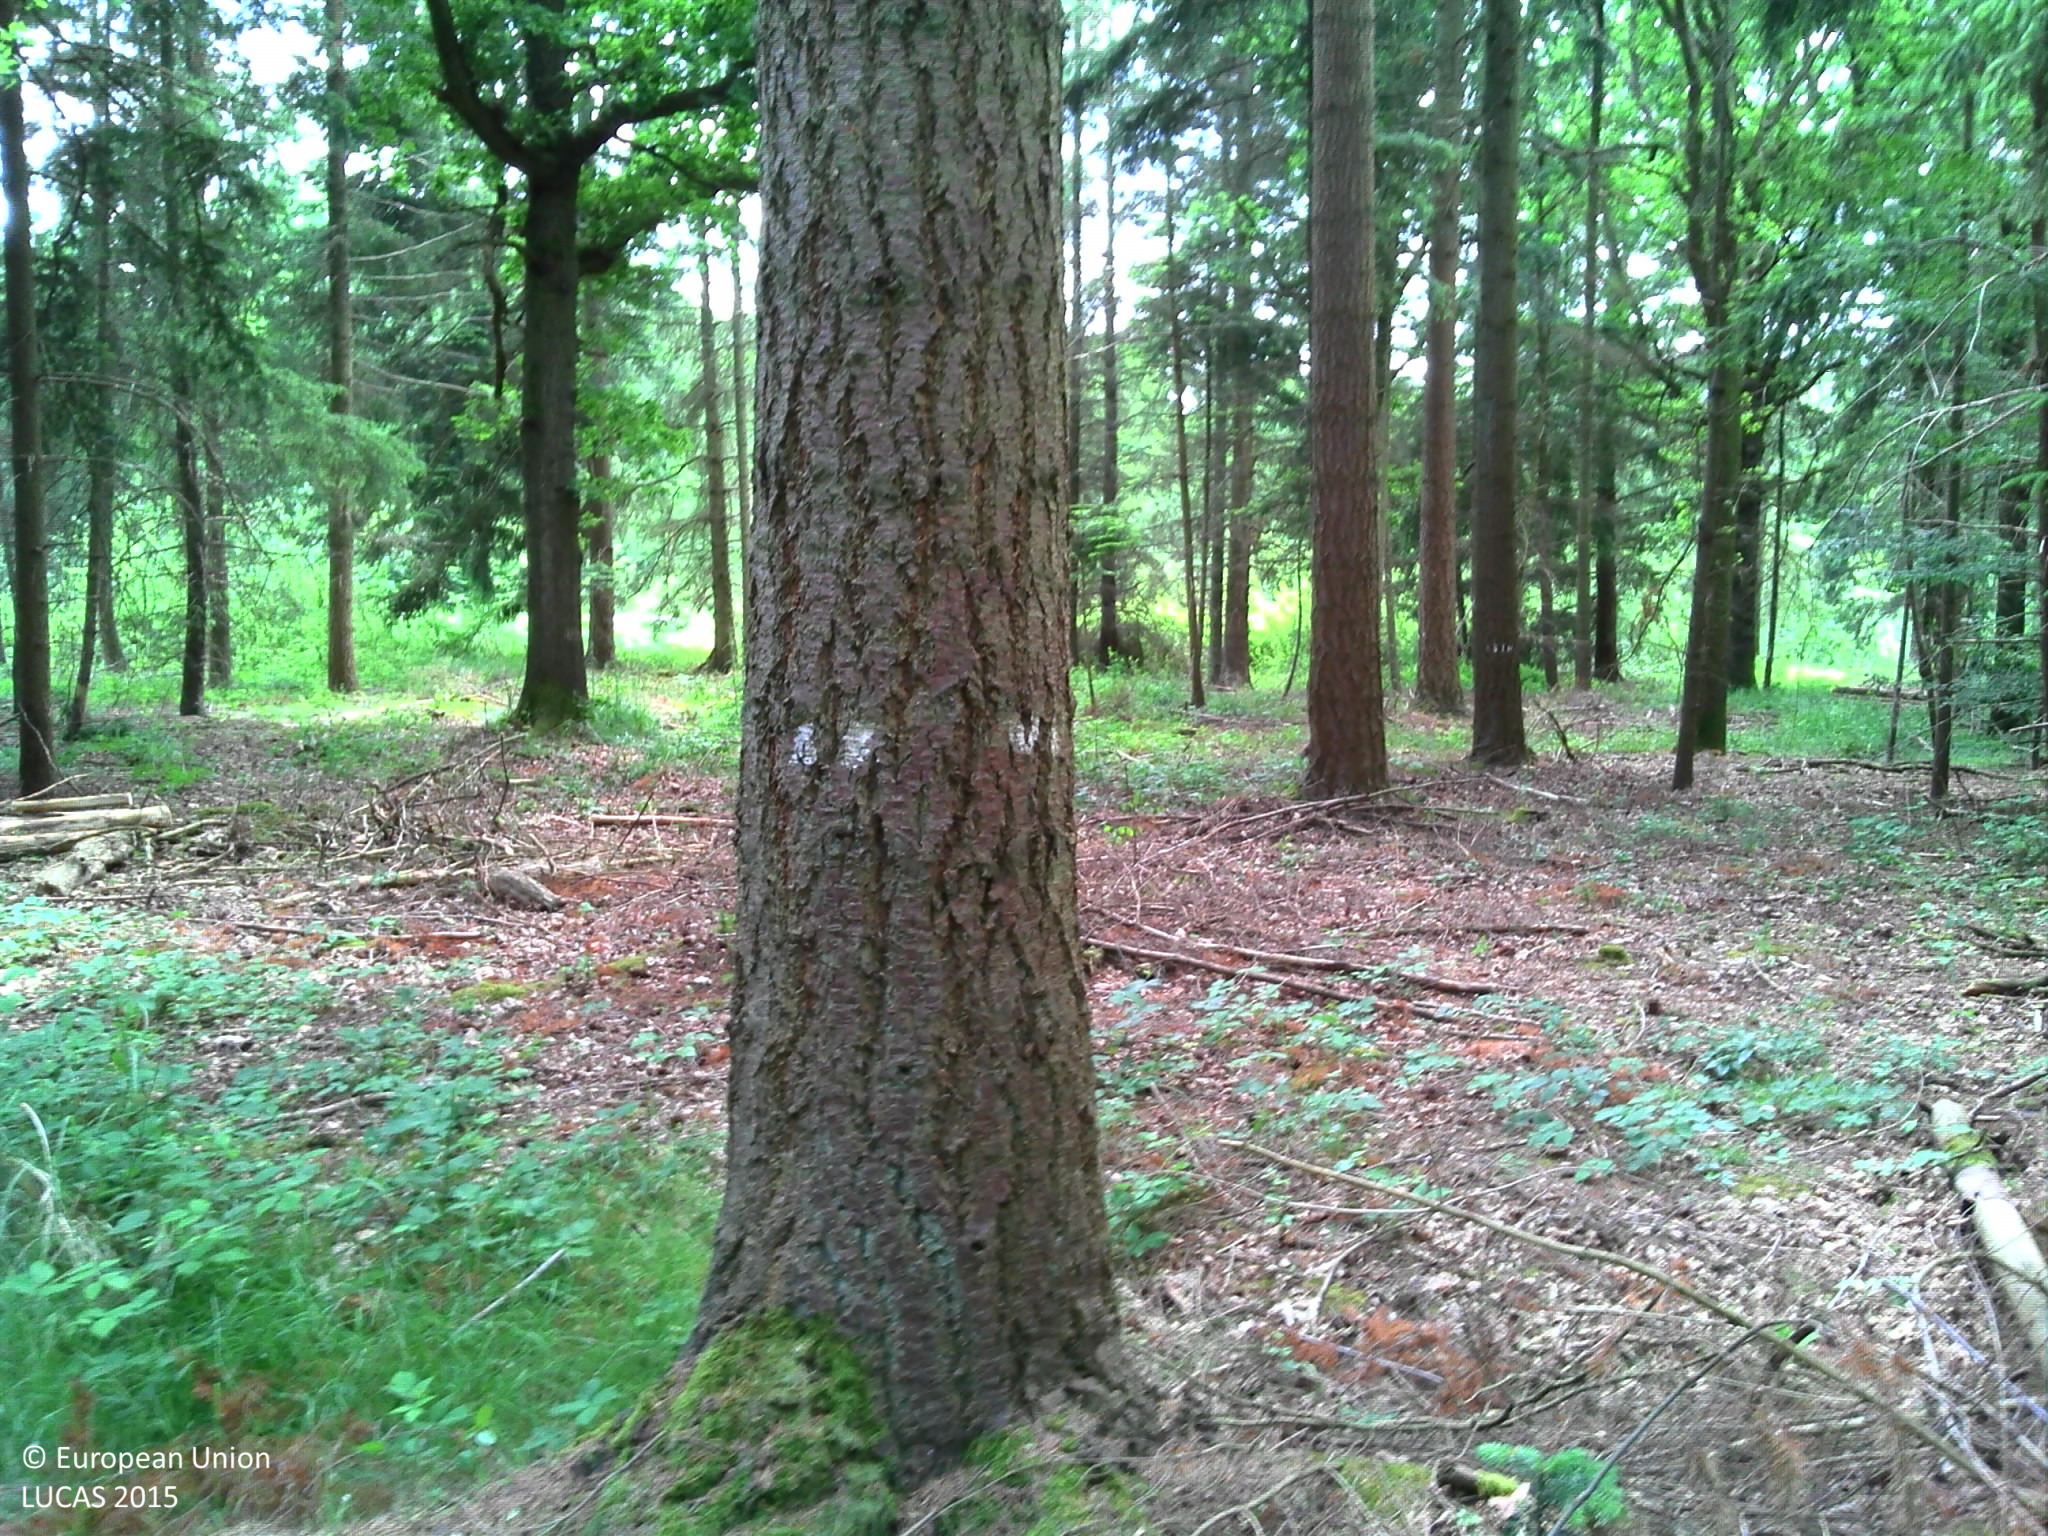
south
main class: Woodland
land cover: Pine dominated mixed woodland
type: exotic forest
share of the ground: > 75 %
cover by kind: coniferous forest trees 60 %, broadleaved forest trees 25 %, lichens and mosses 10 %, herbaceous plants 5 %
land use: Forestry
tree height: > 5 m
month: June
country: FR
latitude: 50.7557
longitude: 2.3174
